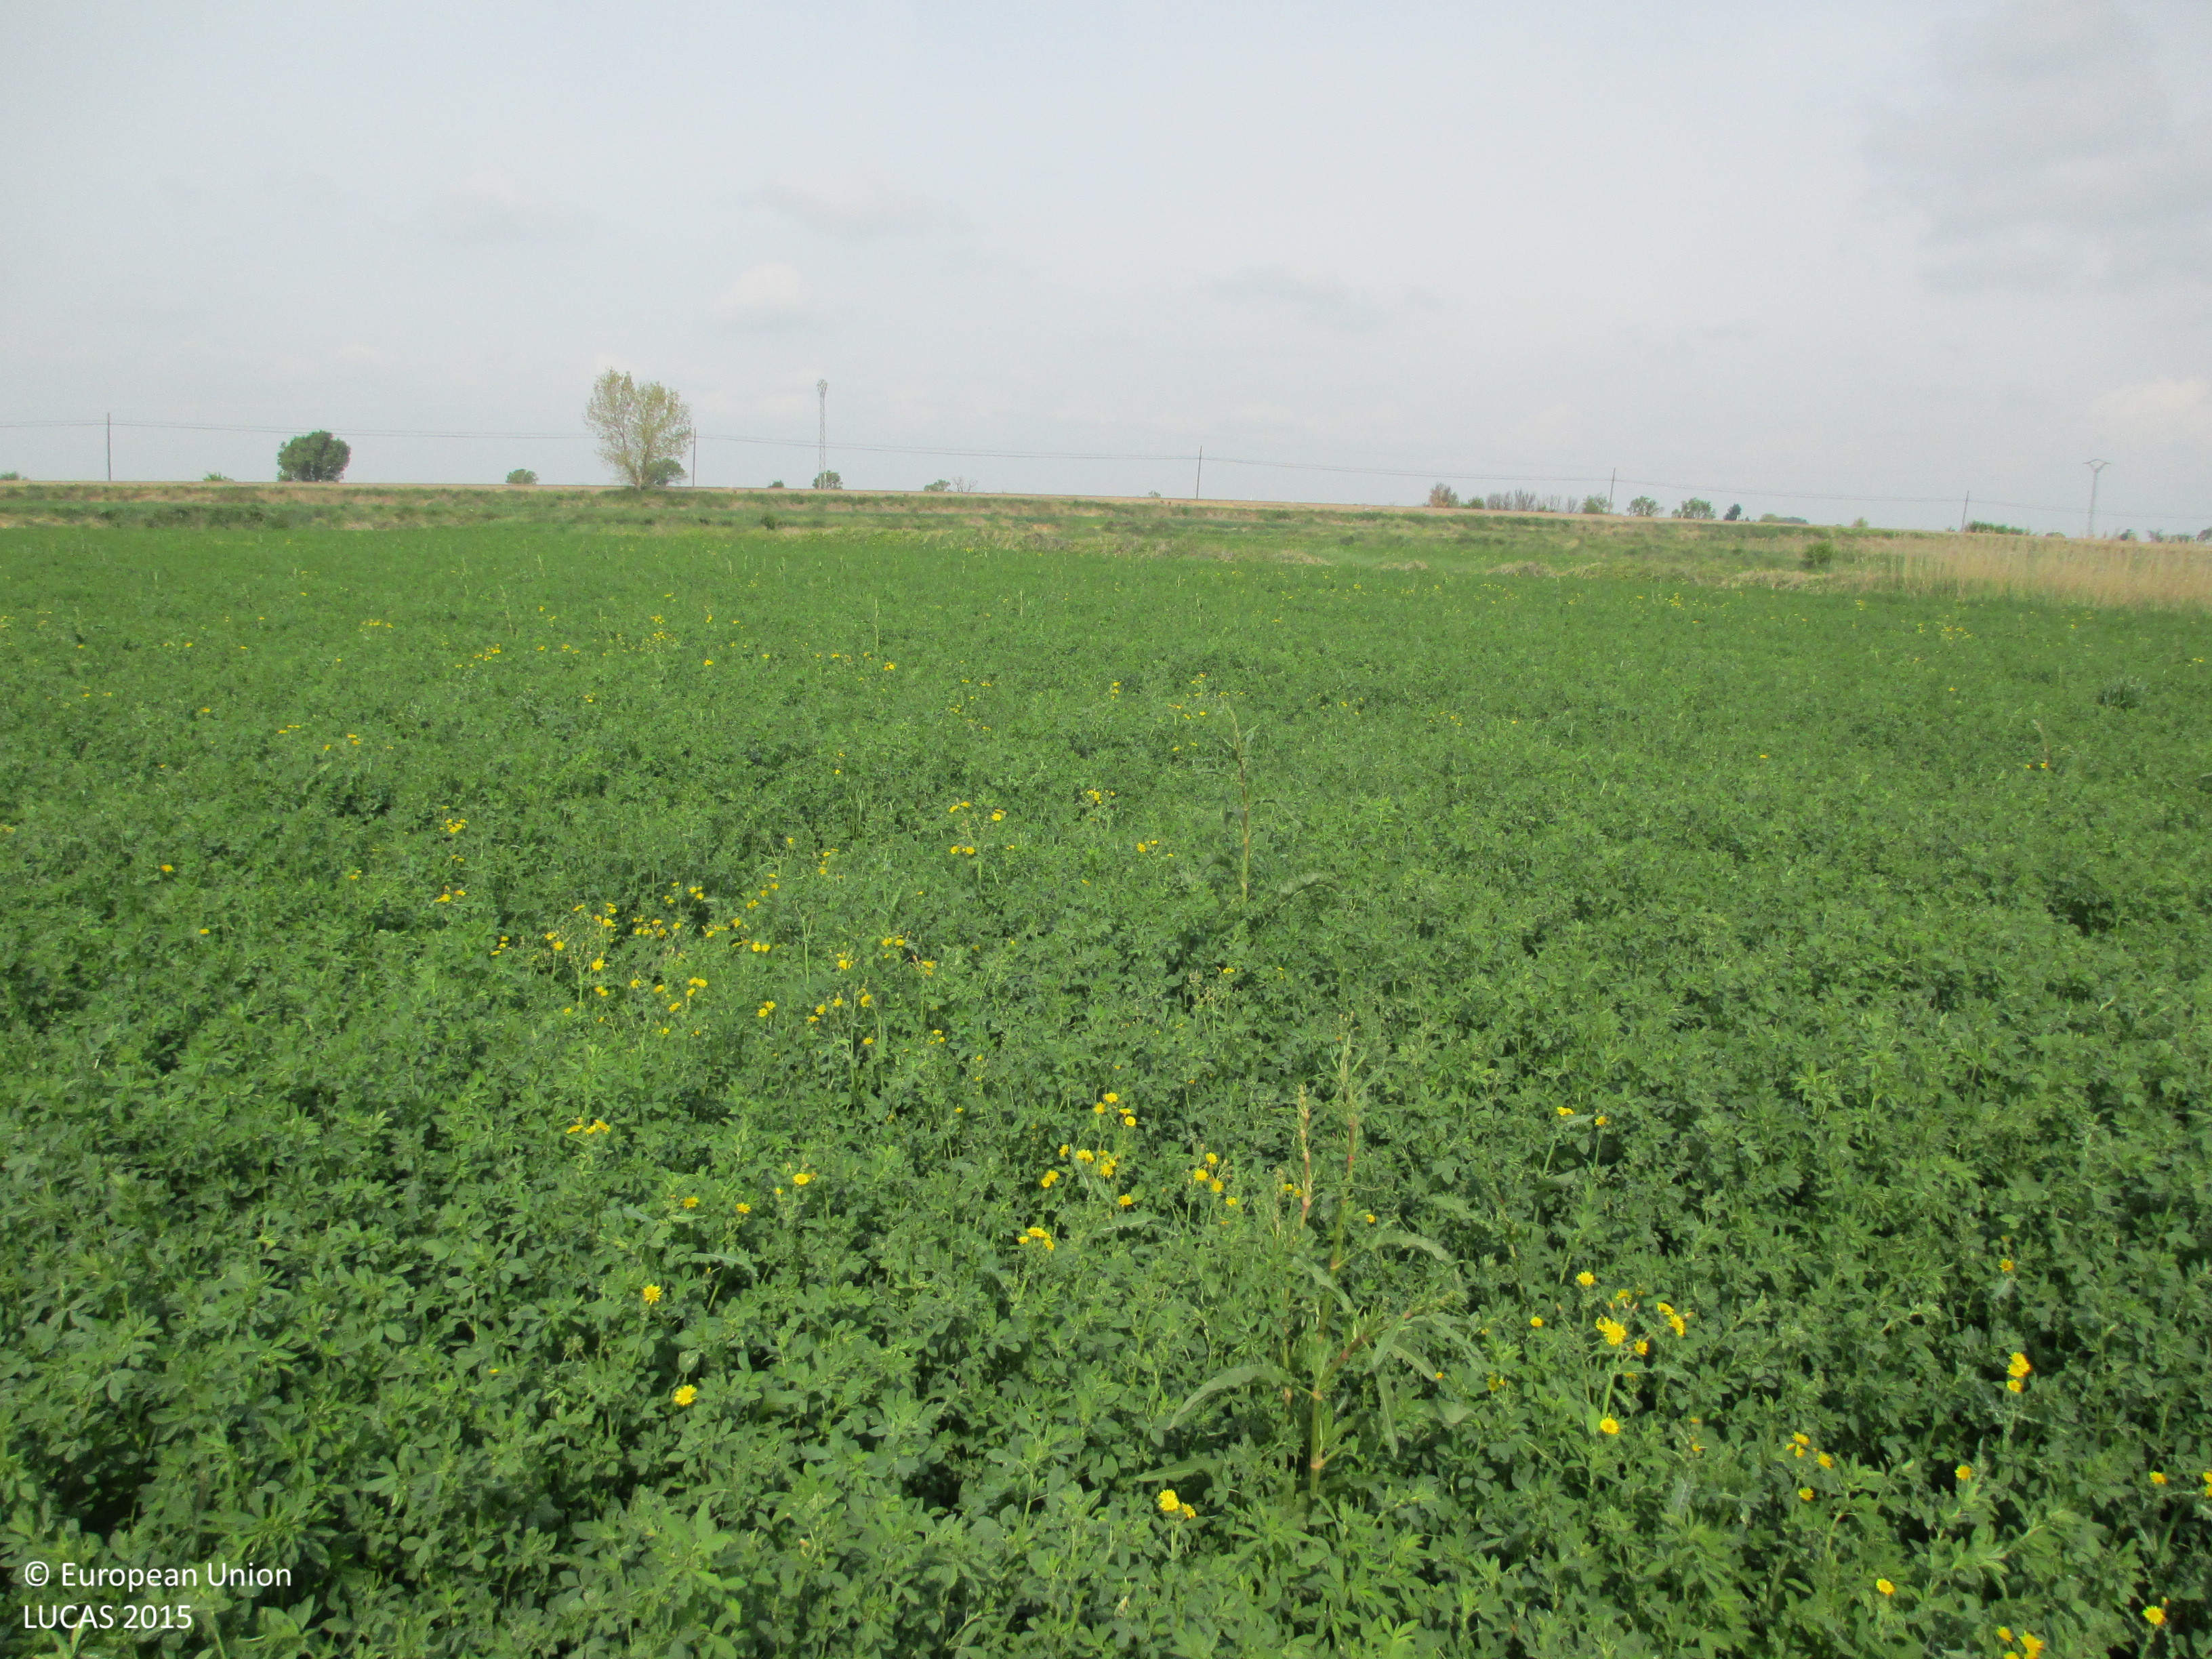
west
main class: Cropland
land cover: Lucerne
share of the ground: > 75 %
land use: Agriculture (excluding fallow land and kitchen gardens)
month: April
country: ES
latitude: 42.0827
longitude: -0.3817
